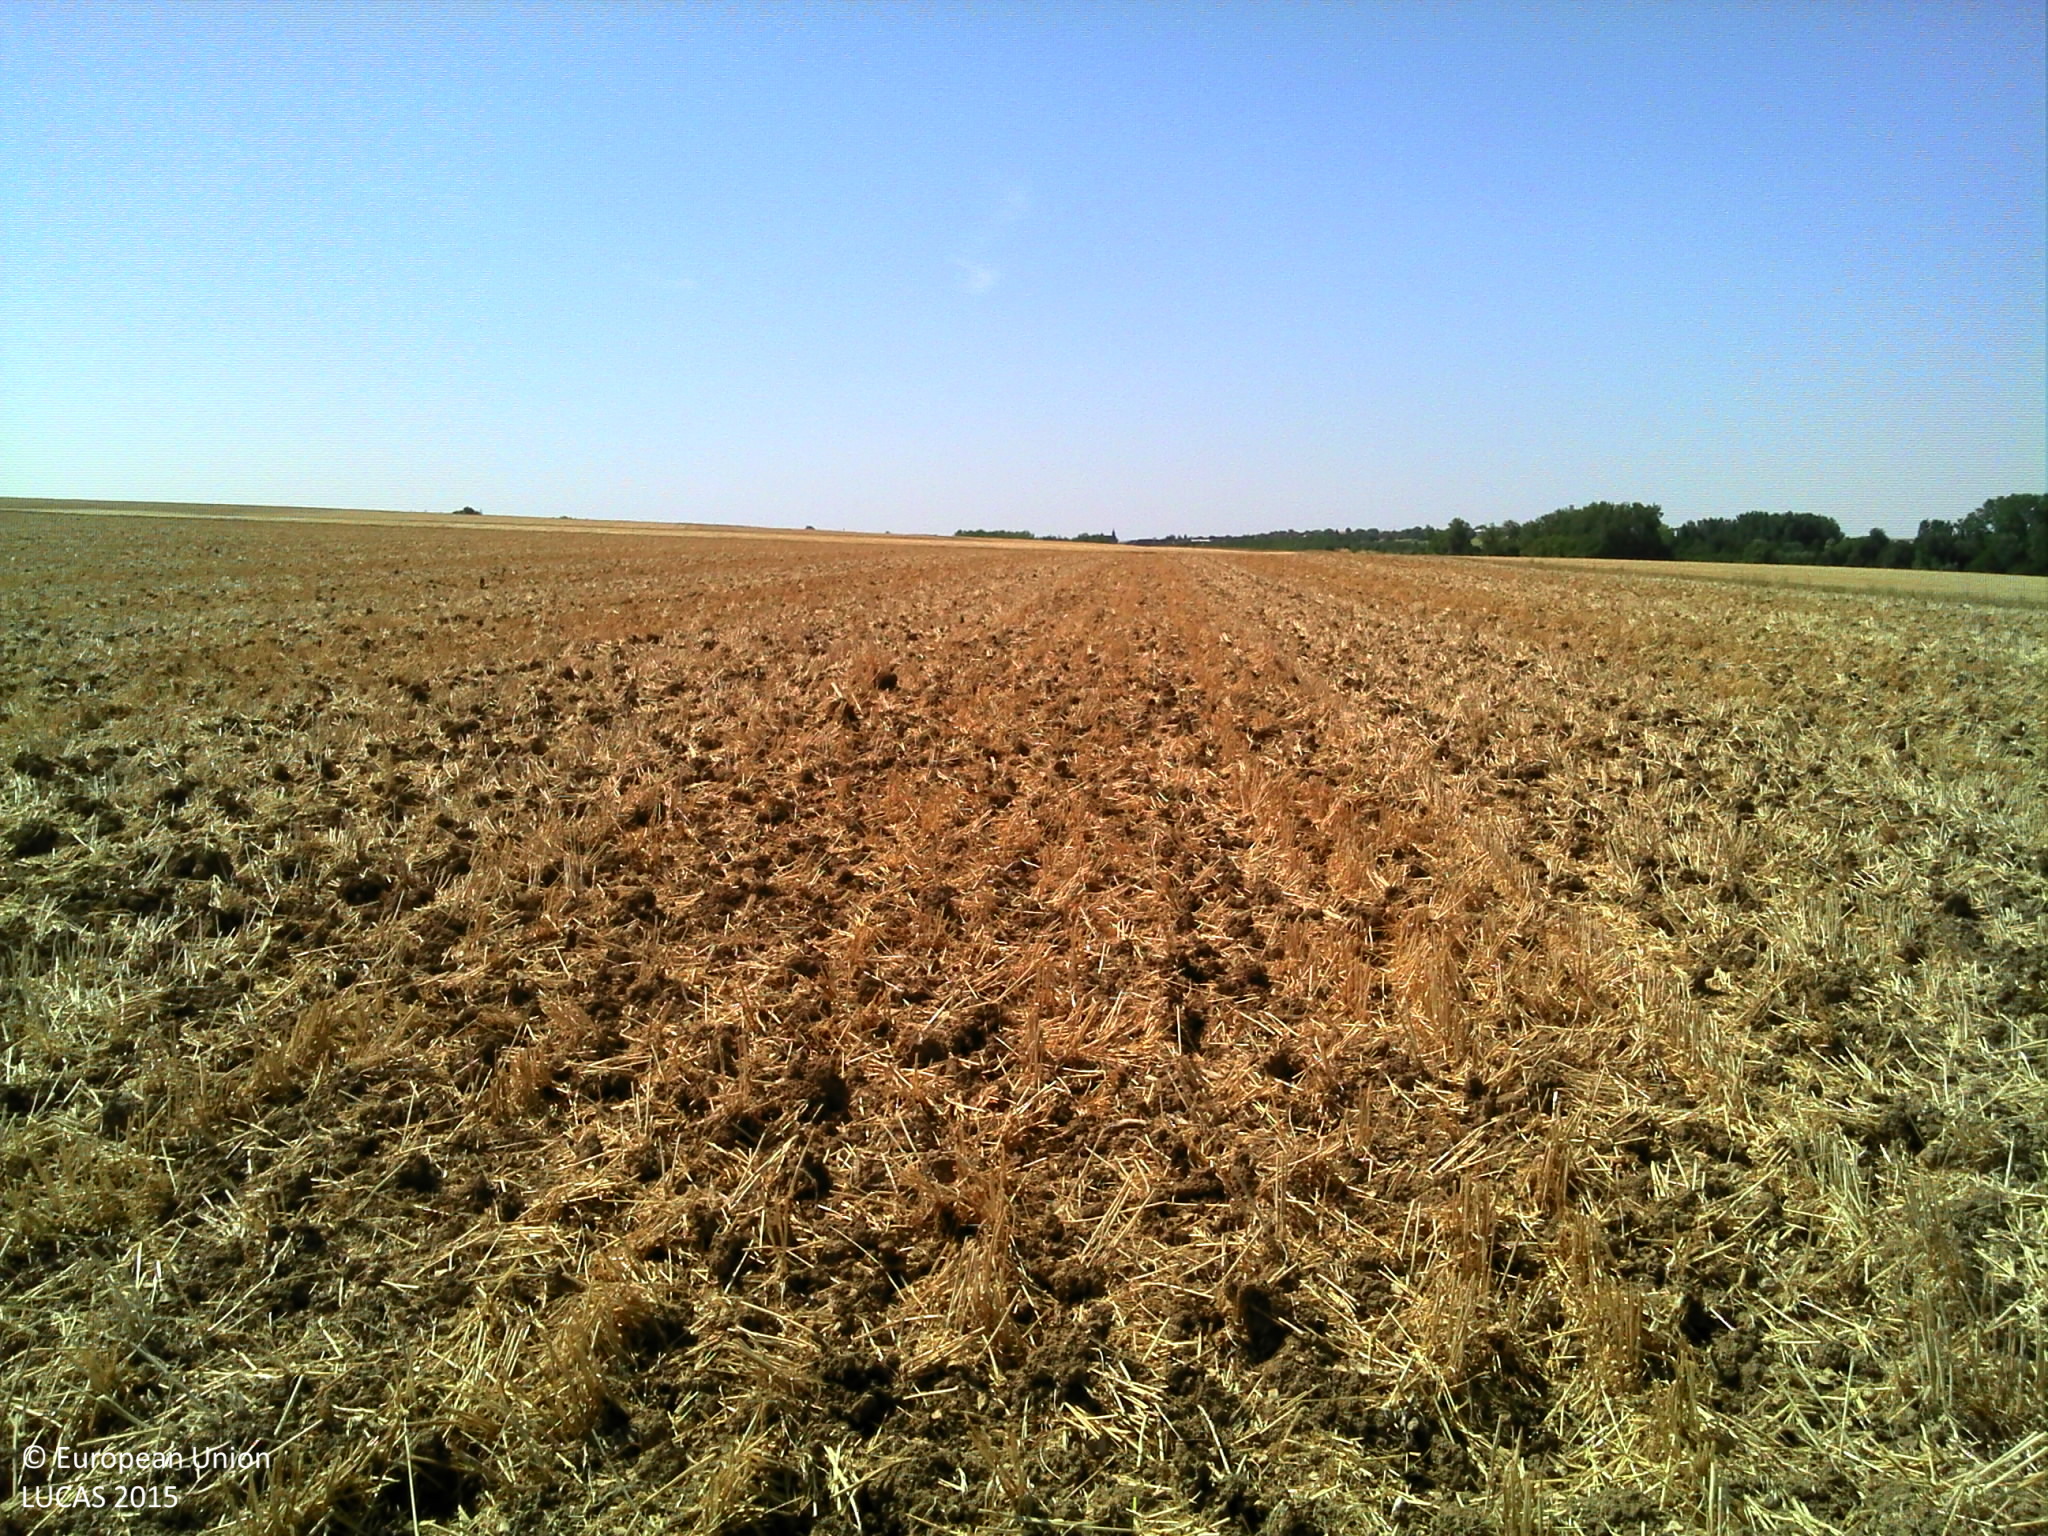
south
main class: Cropland
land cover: Common wheat
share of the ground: > 75 %
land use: Agriculture (excluding fallow land and kitchen gardens)
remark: Tilled/Sowed
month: August
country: FR
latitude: 47.9384
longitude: 3.4488
